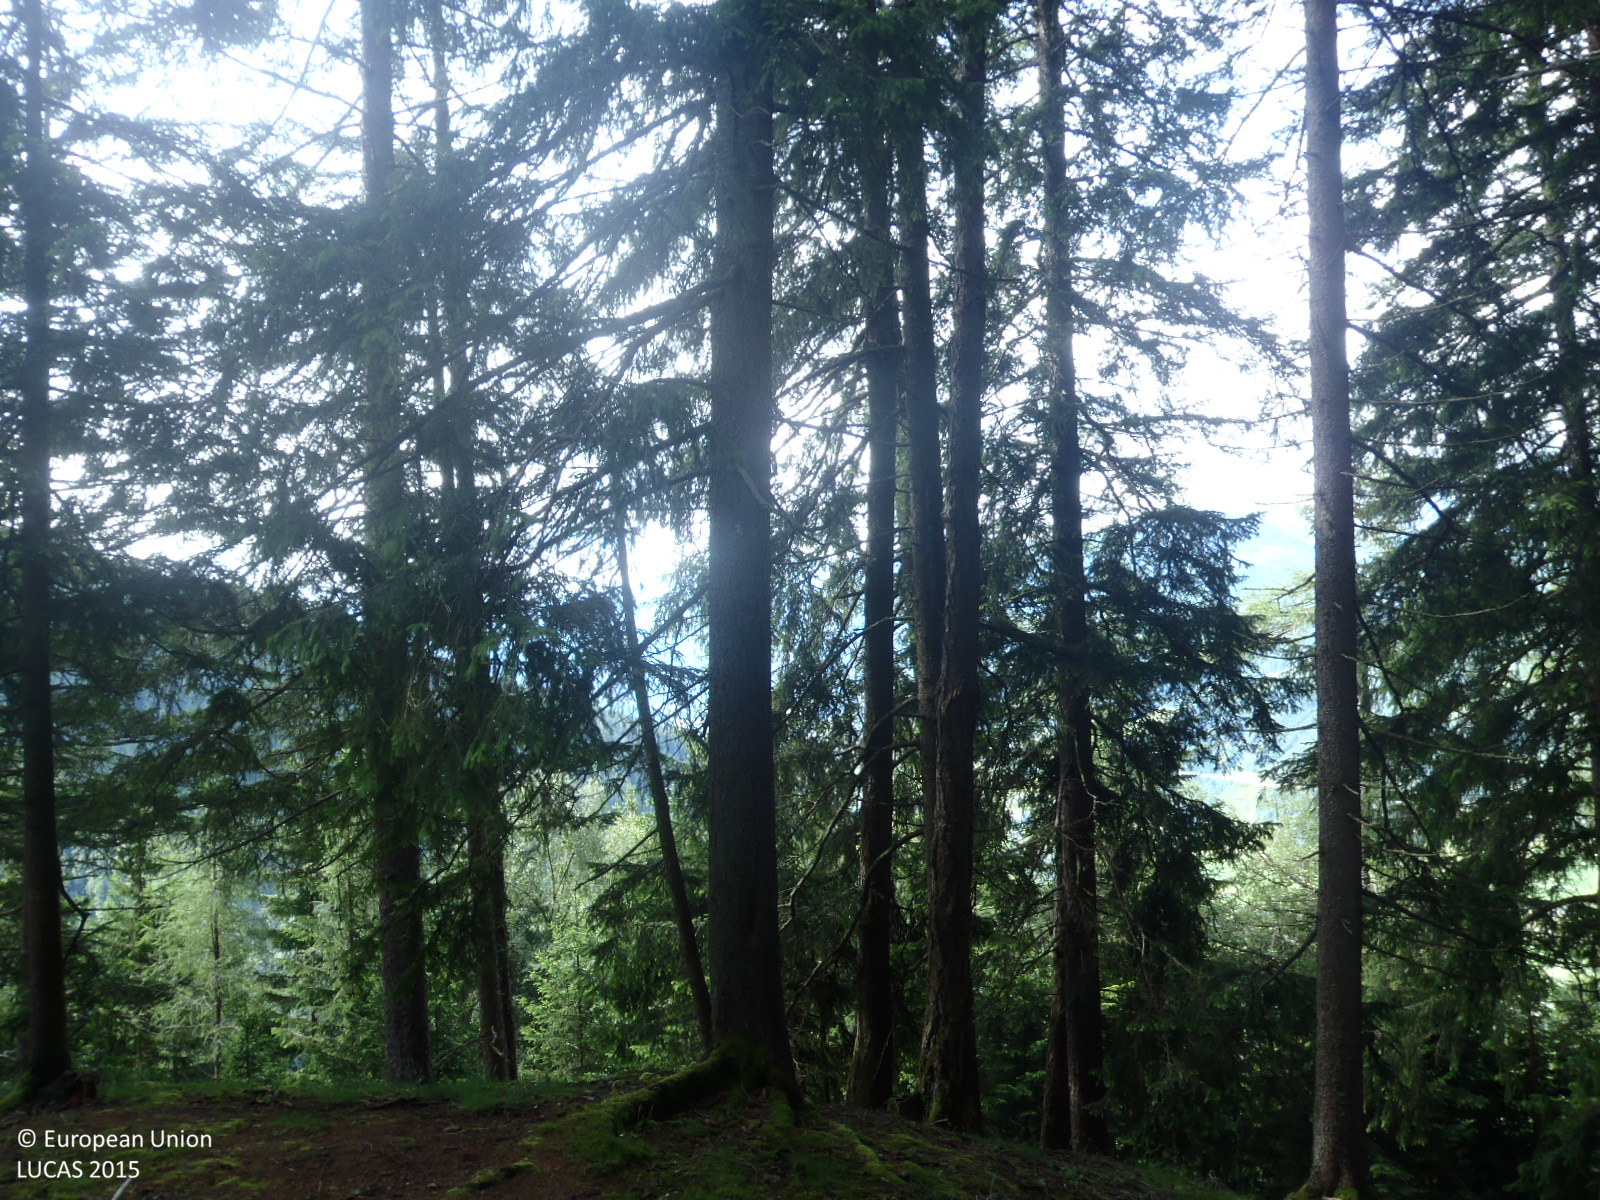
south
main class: Woodland
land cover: Spruce dominated coniferous woodland
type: alpine coniferous forest
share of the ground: > 75 %
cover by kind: coniferous forest trees 90 %, herbaceous plants 5 %, lichens and mosses 5 %
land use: Forestry
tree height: > 5 m
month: June
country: AT
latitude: 47.1697
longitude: 11.4630
